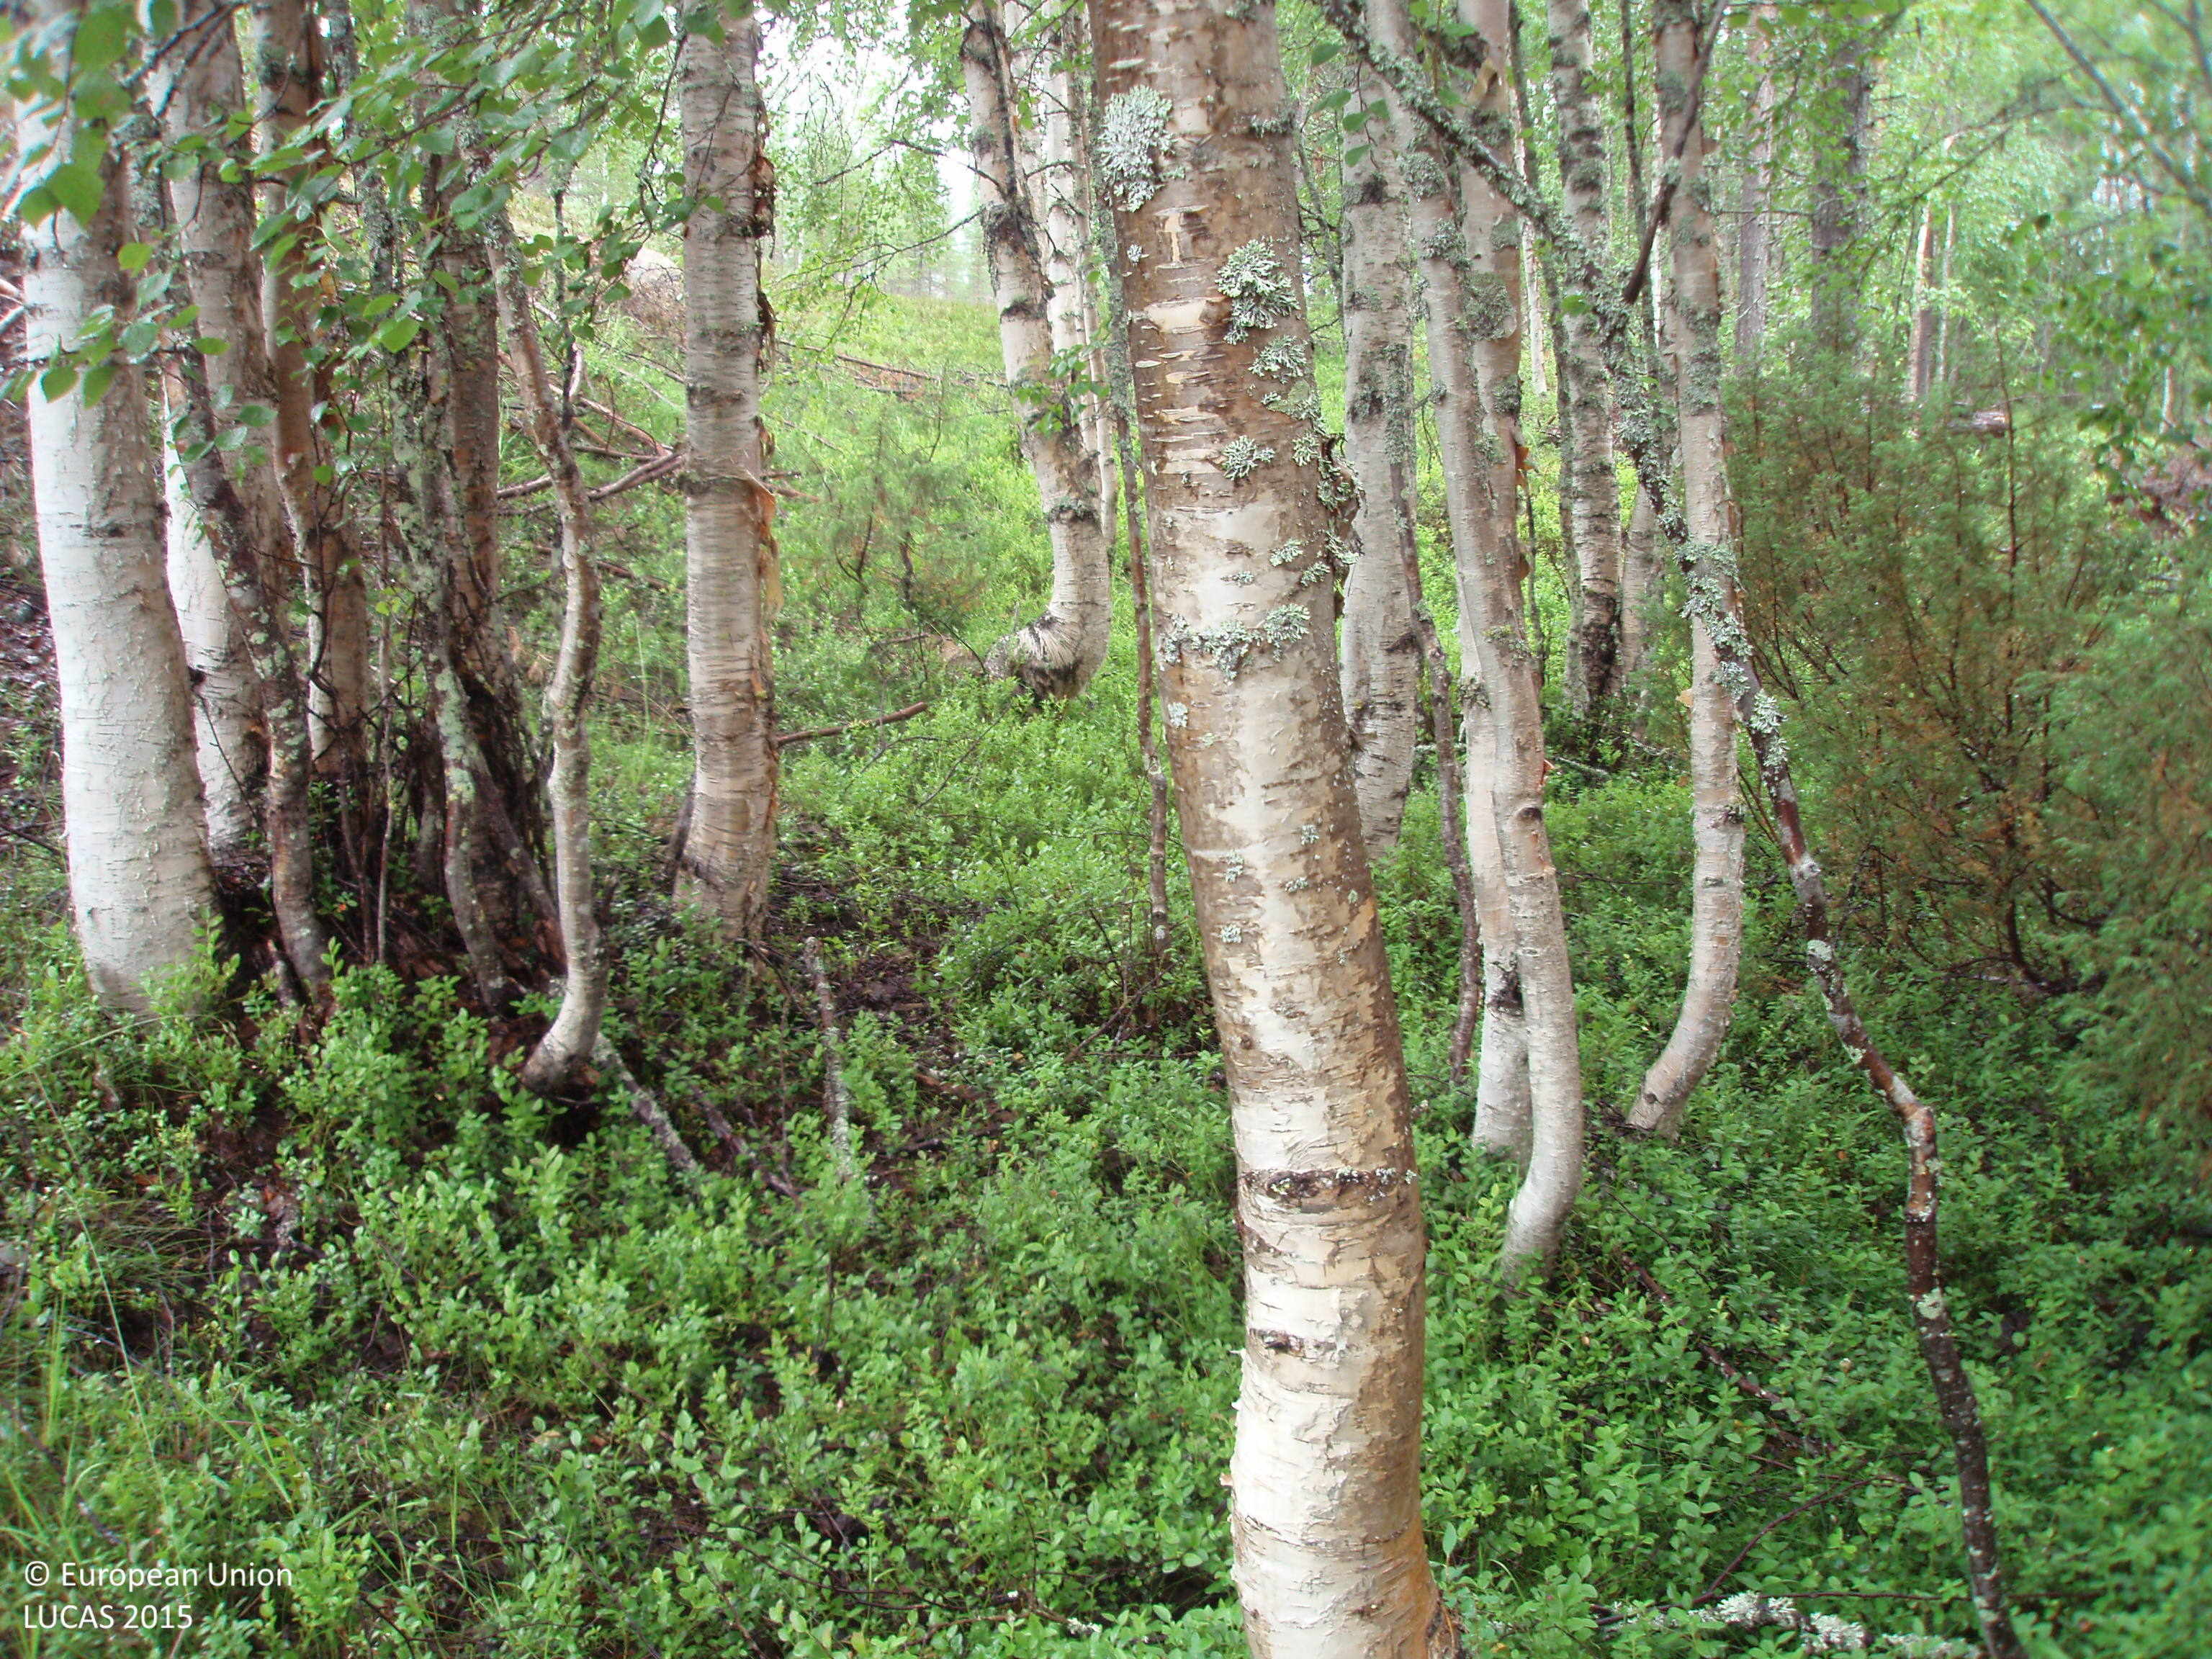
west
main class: Woodland
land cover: Broadleaved woodland
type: boreal forest
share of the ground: > 75 %
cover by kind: broadleaved forest trees 85 %, shrubs 10 %, coniferous forest trees 5 %
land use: Forestry
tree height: > 5 m
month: August
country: FI
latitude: 65.5879
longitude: 27.5416
